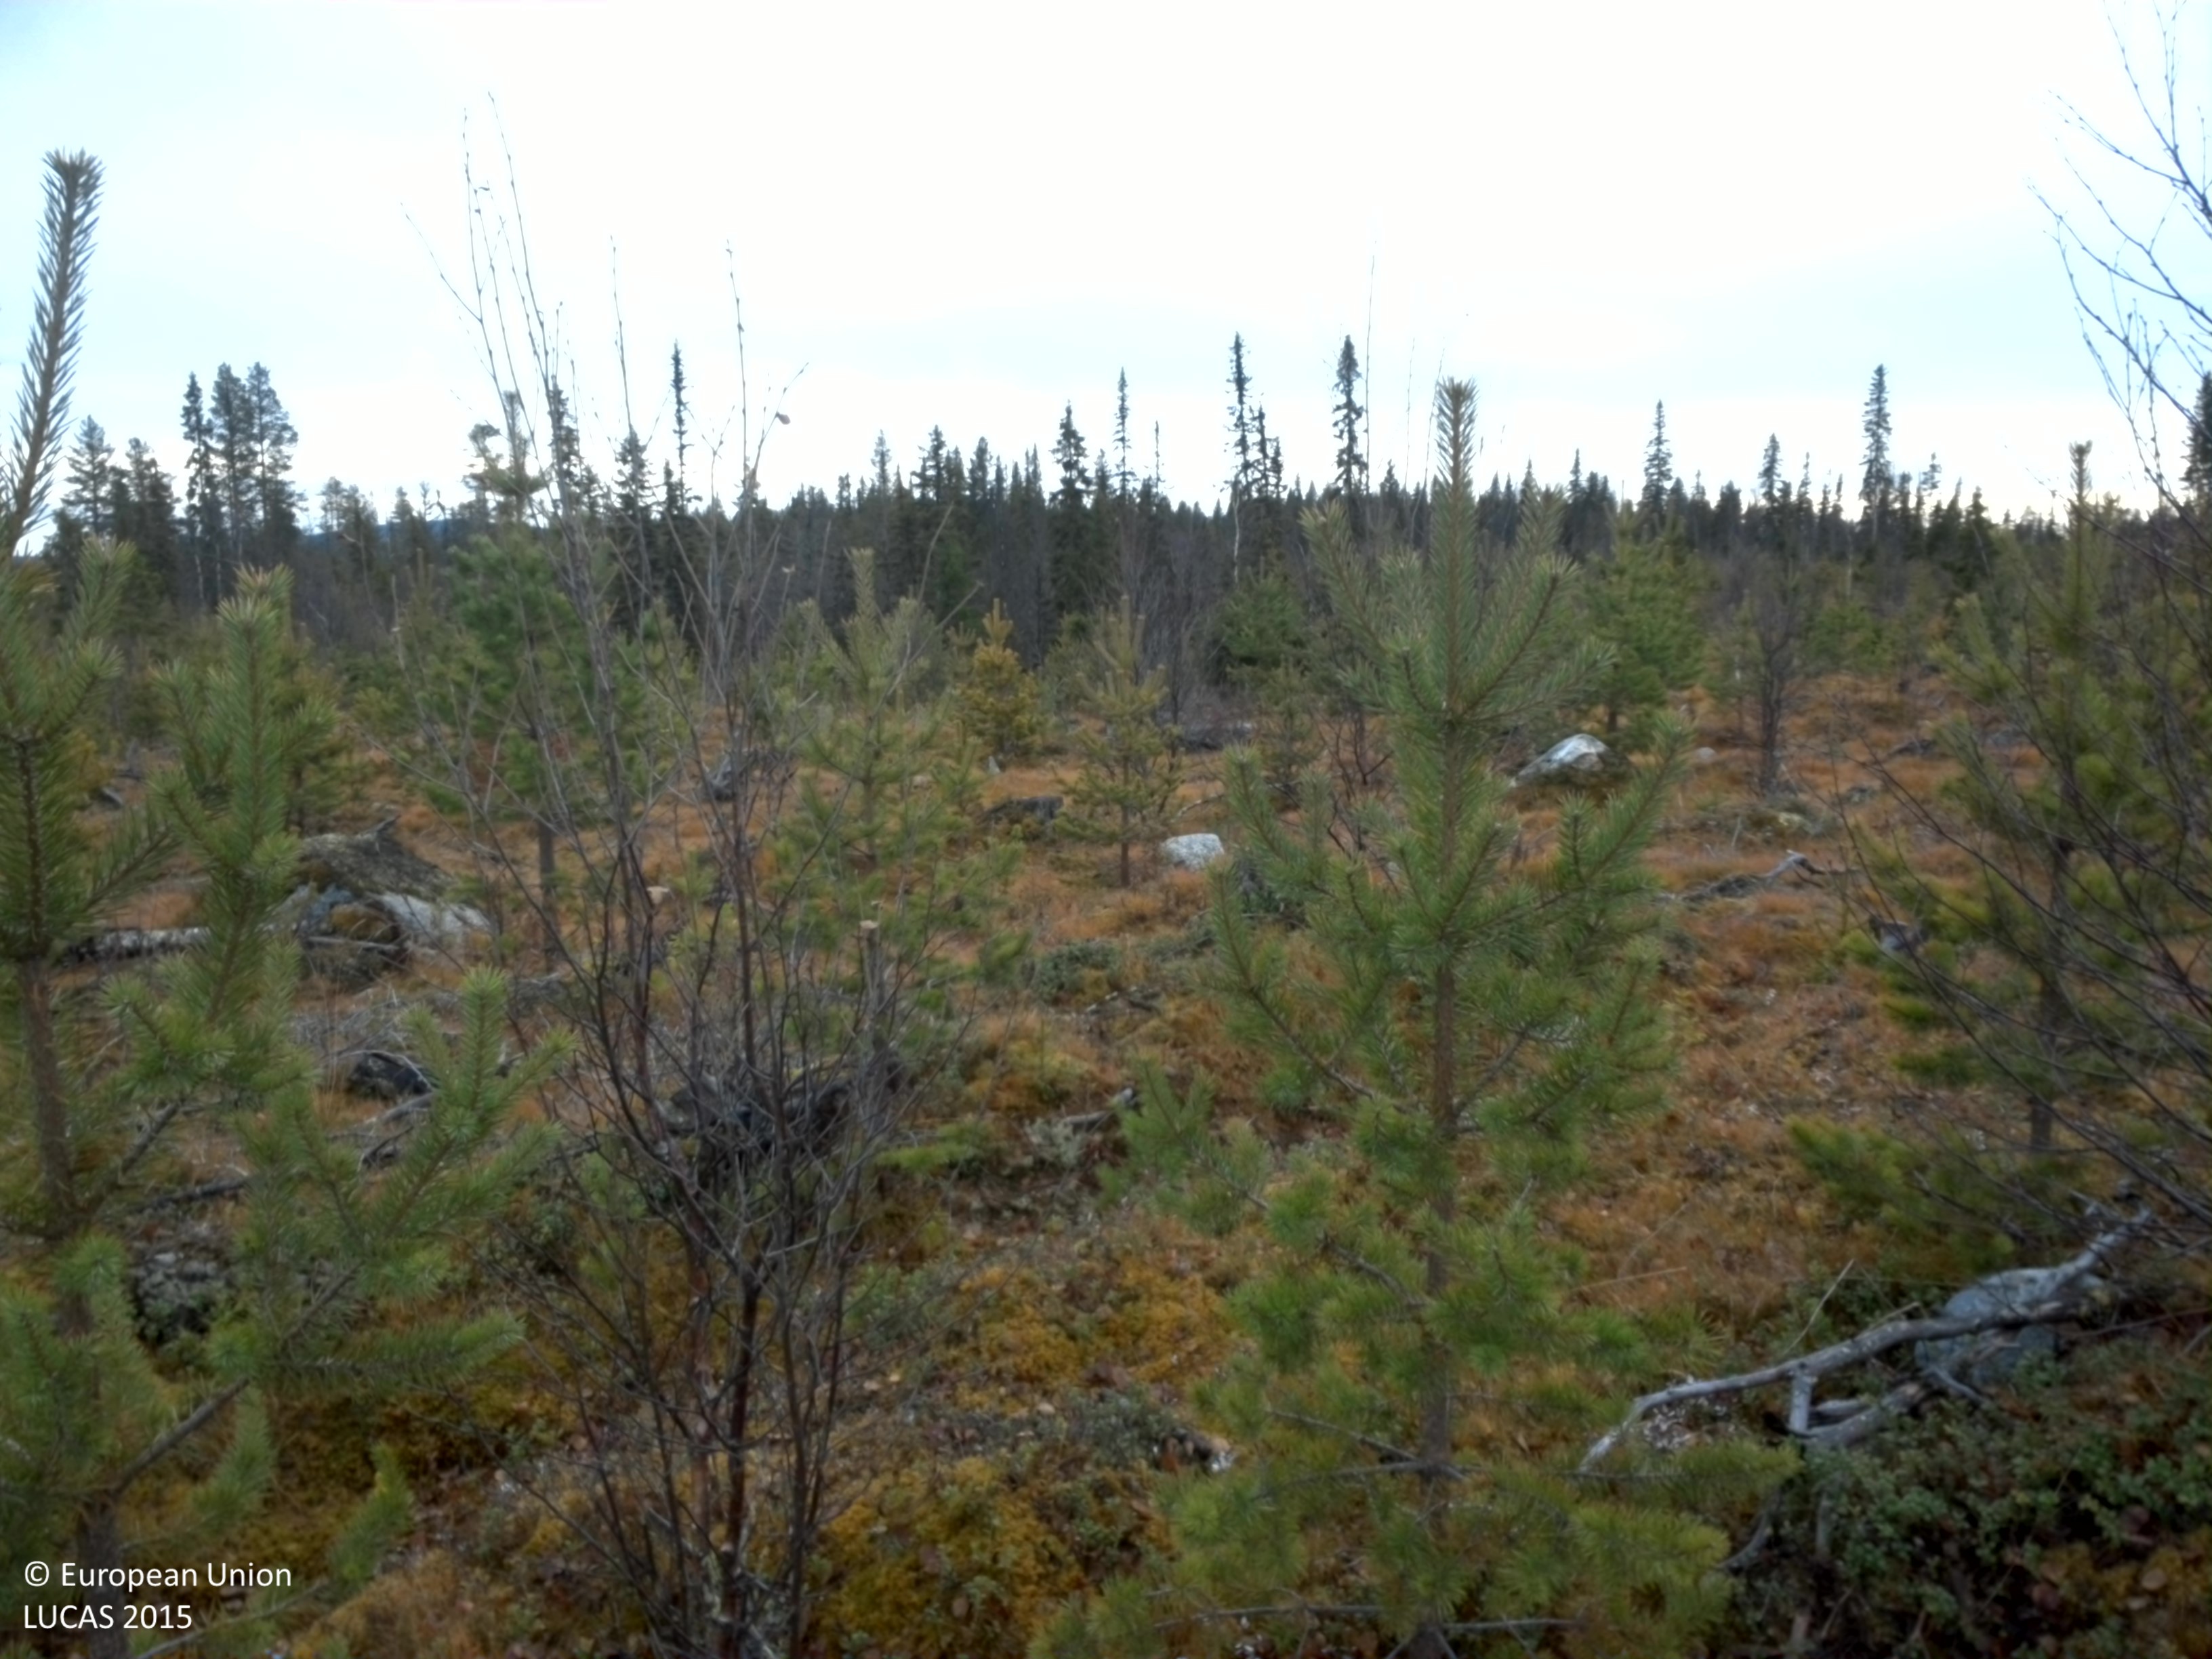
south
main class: Woodland
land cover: Pine dominated mixed woodland
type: boreal forest
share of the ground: 10 - 25 %
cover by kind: herbaceous plants 50 %, shrubs 20 %, lichens and mosses 20 %, coniferous forest trees 5 %, broadleaved forest trees 5 %
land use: Forestry
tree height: < 5 m
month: October
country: SE
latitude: 64.5157
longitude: 17.4035
